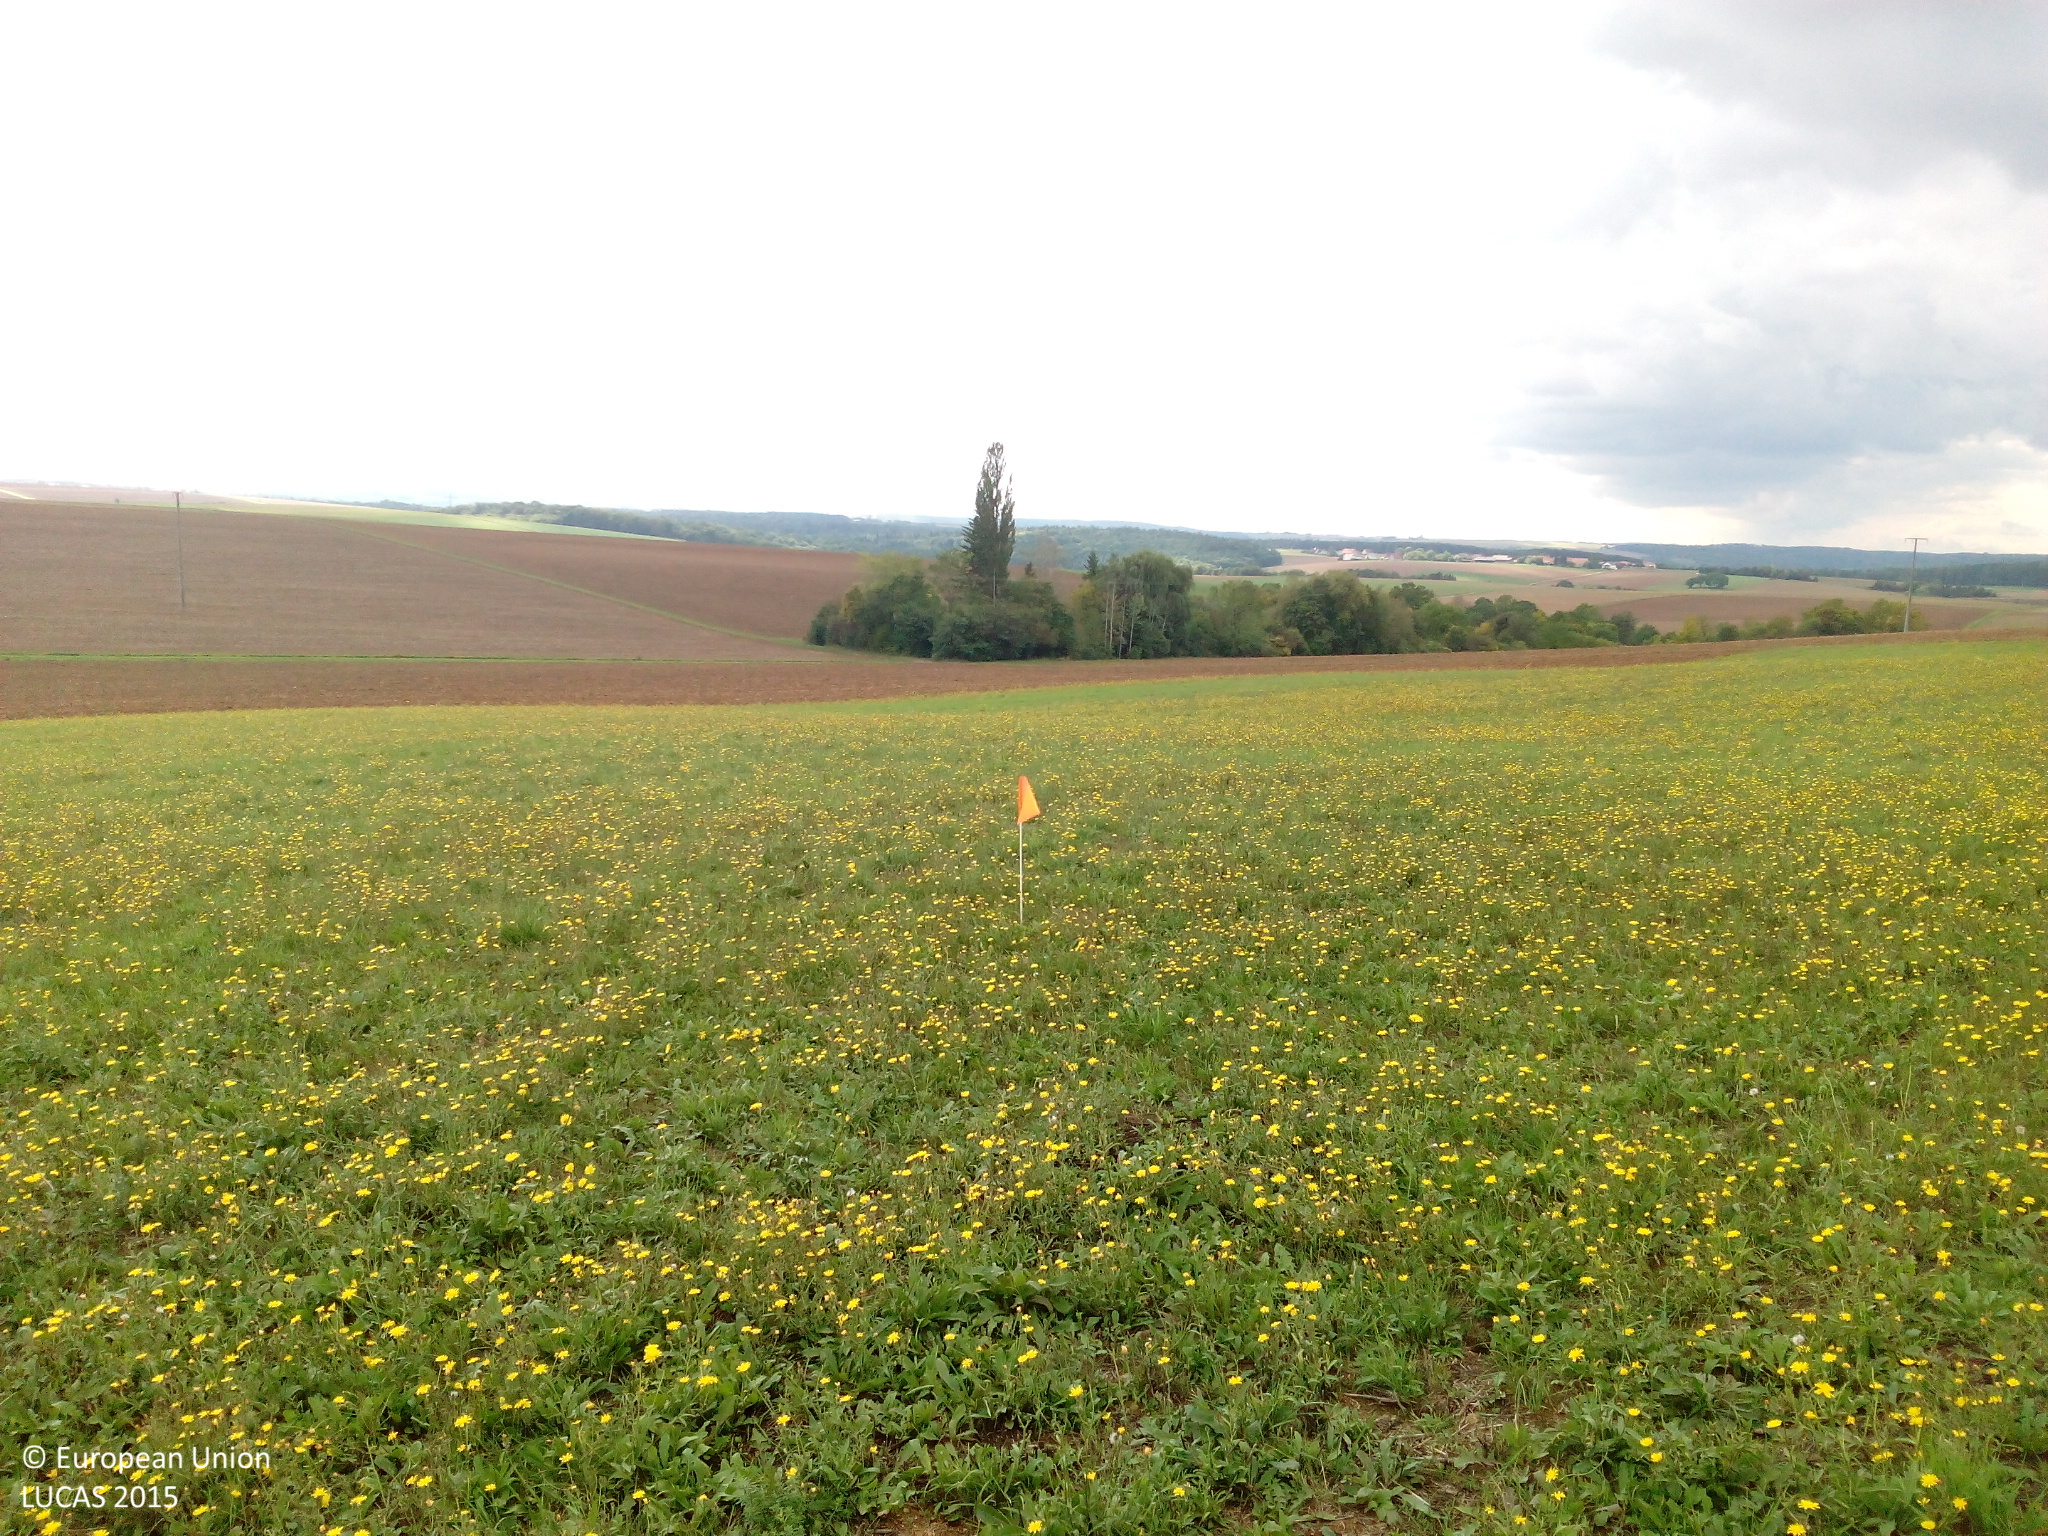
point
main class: Grassland
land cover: Grassland without tree/shrub cover
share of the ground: > 75 %
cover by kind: herbaceous plants 90 %, unconsolidated bare surface 10 %
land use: Agriculture (excluding fallow land and kitchen gardens)
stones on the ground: 10 - 25 %
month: September
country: DE
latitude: 49.8605
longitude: 9.9305
